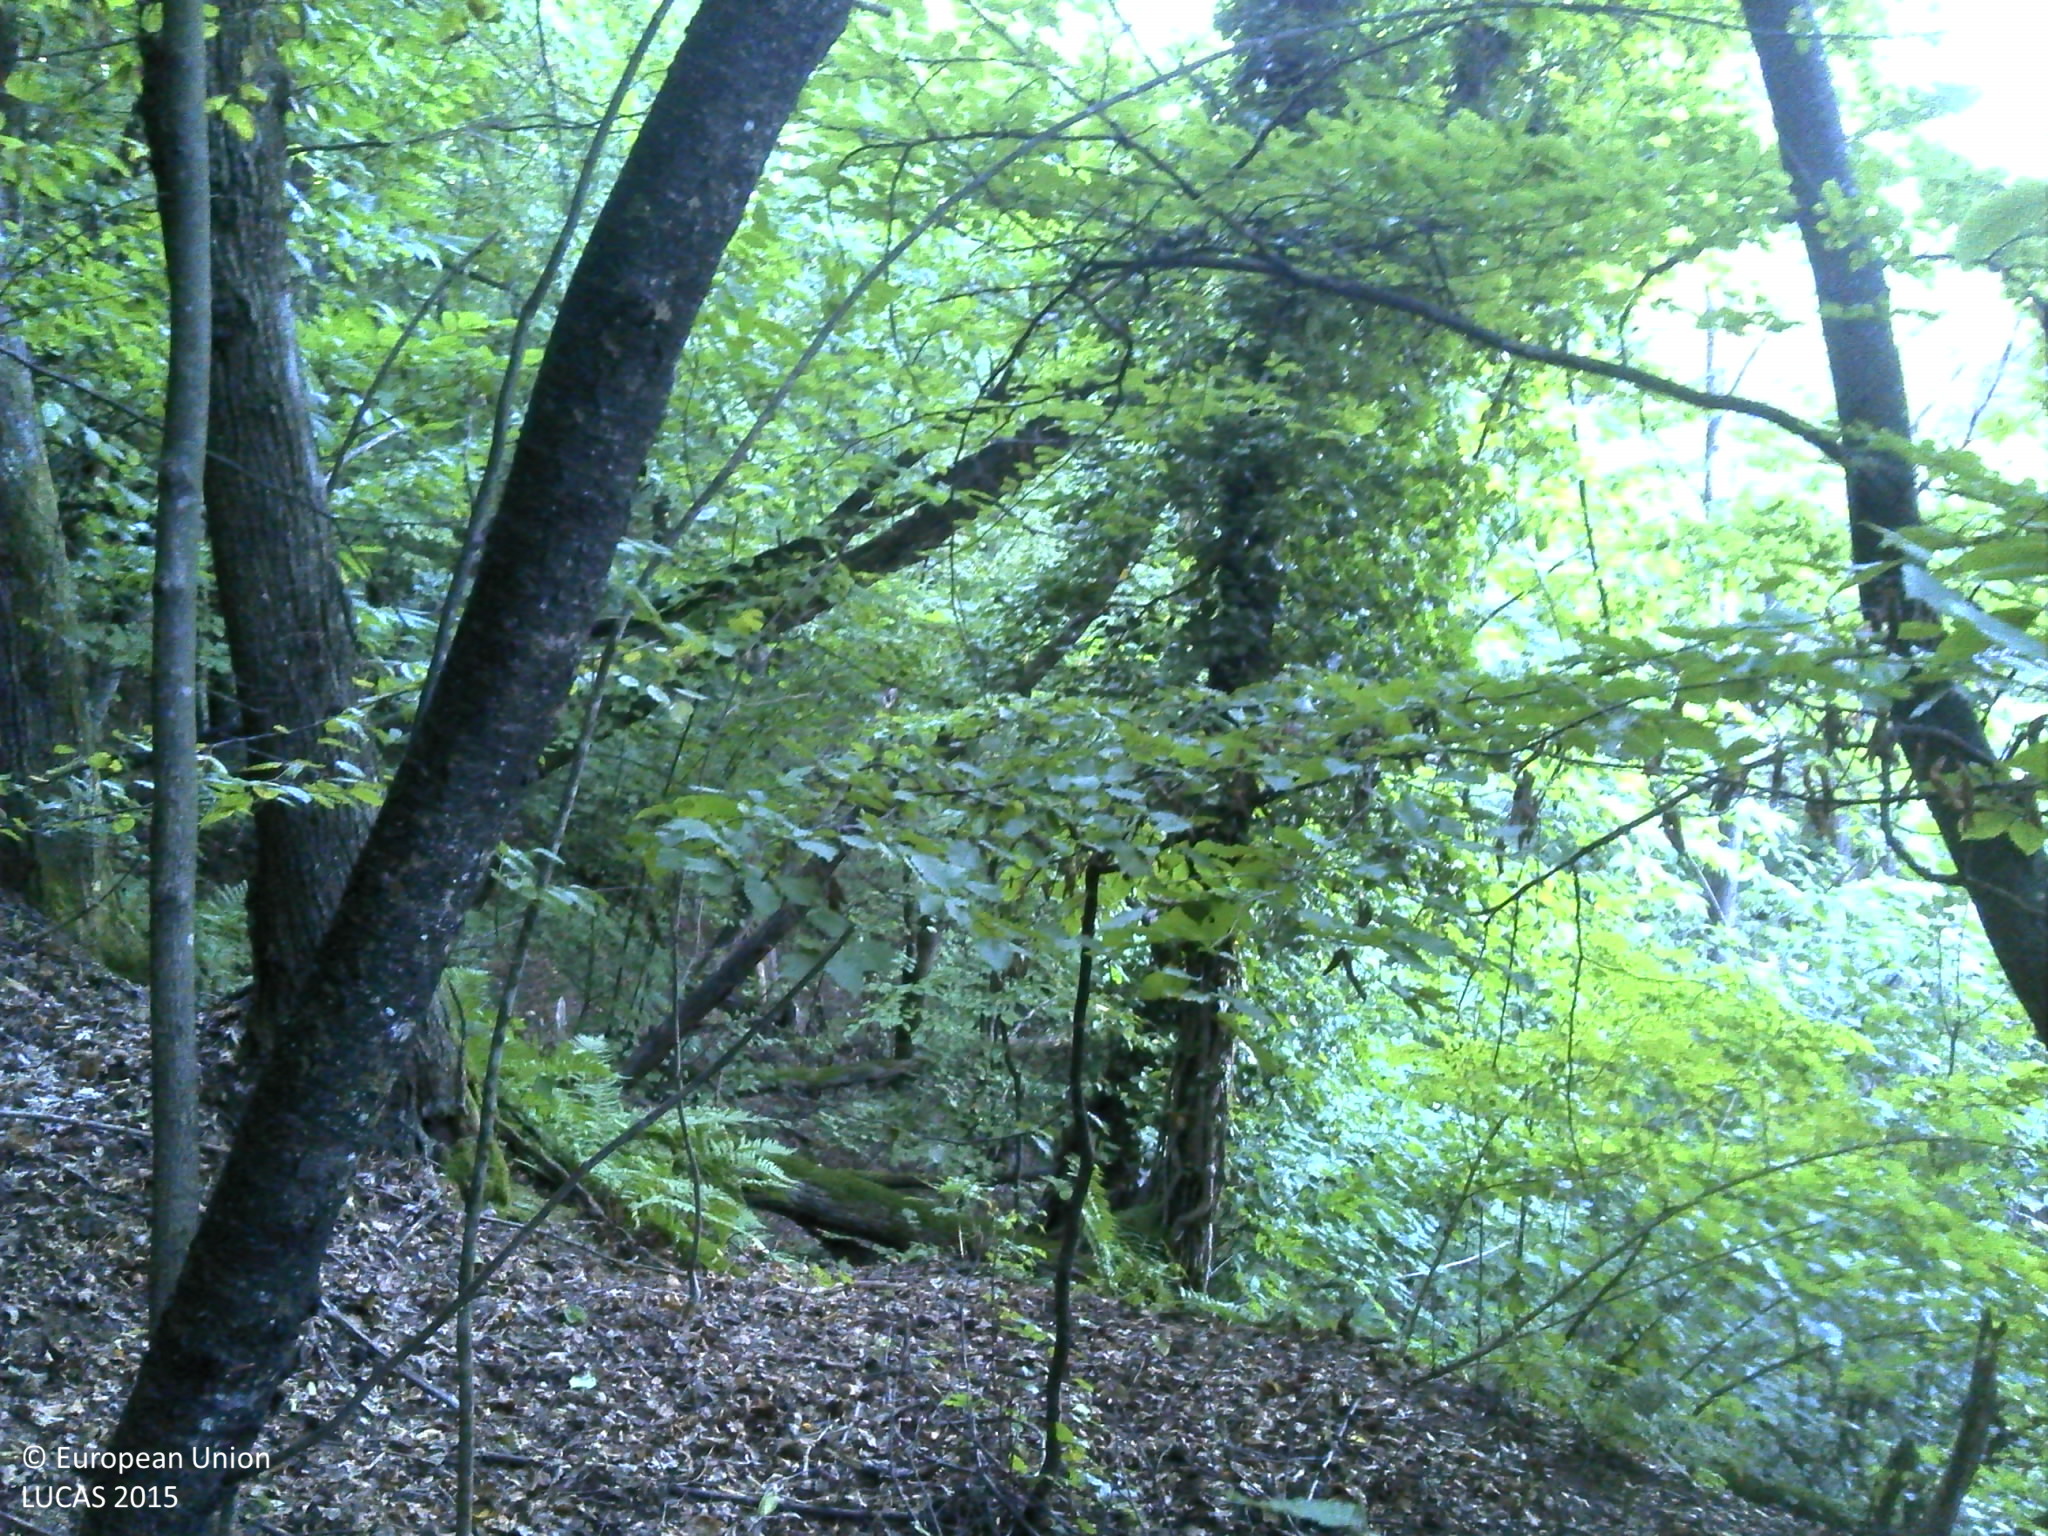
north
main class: Woodland
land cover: Broadleaved woodland
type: acidophilous oak and oak-birch forest
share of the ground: > 75 %
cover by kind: broadleaved forest trees 100 %
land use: Forestry
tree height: > 5 m
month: August
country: HR
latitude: 45.2586
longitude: 16.3560
